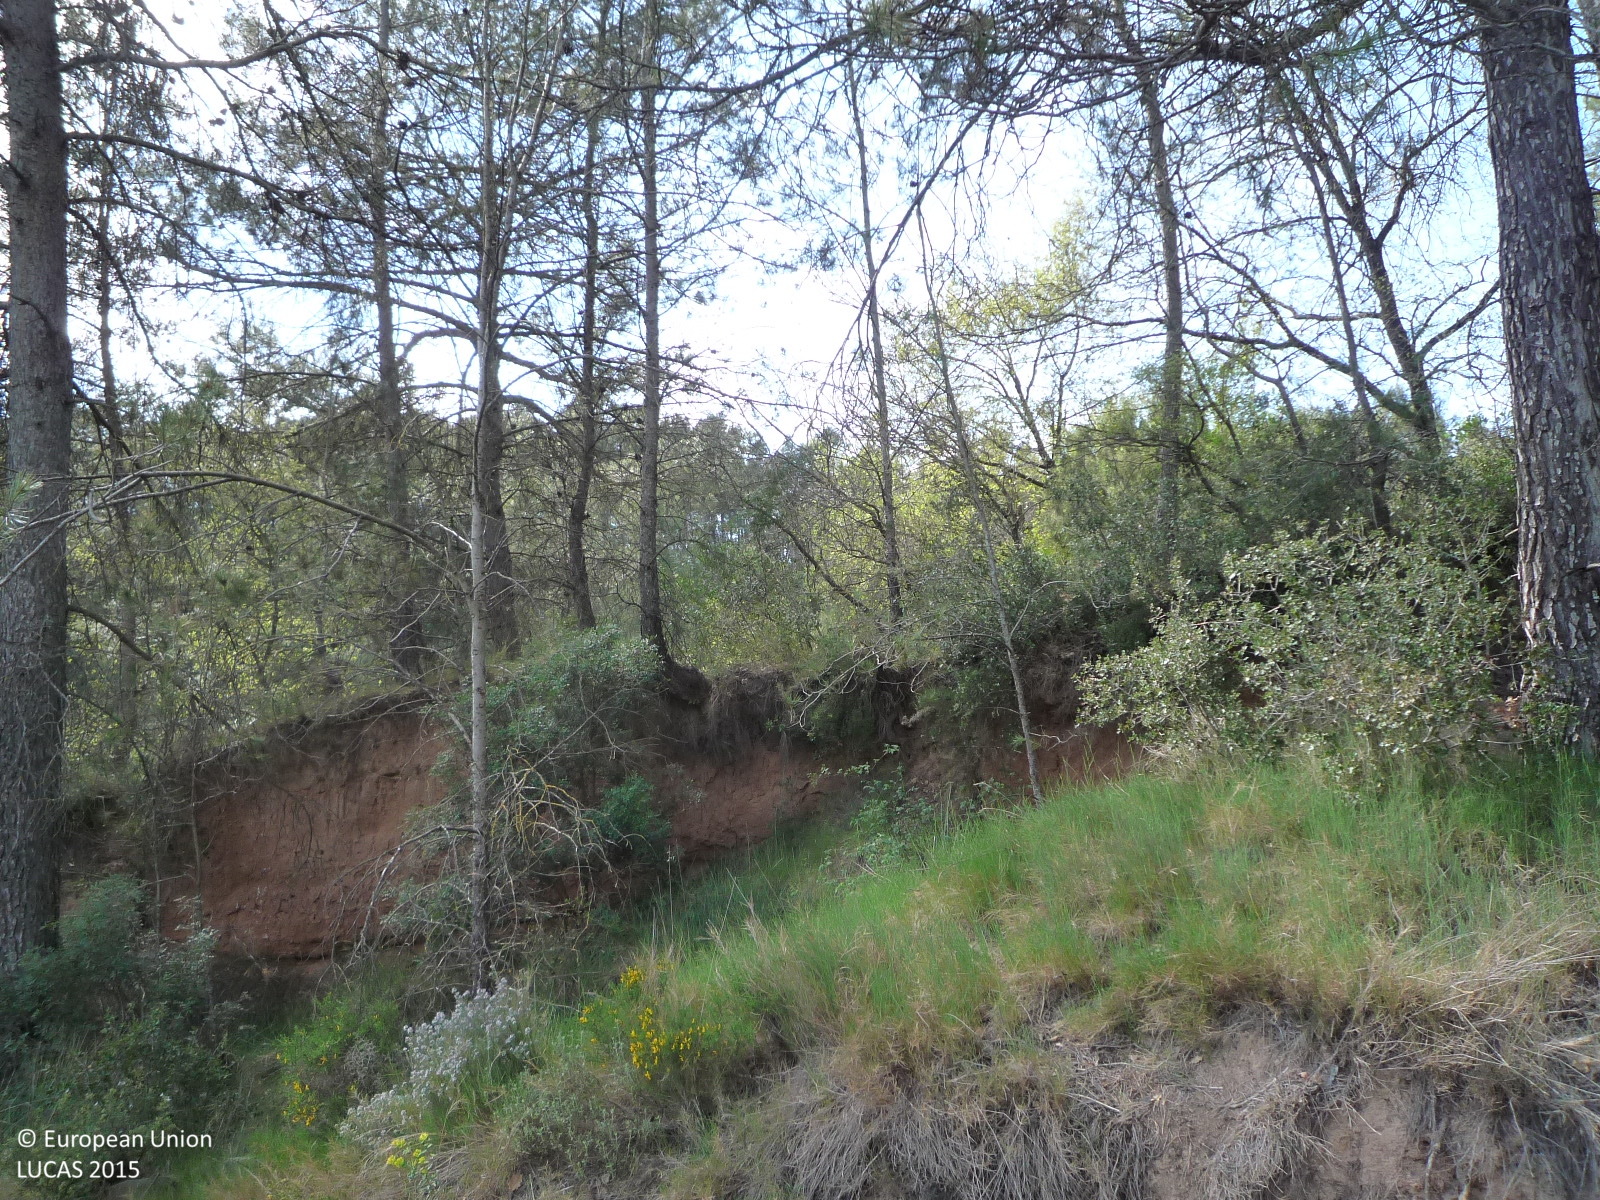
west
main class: Cropland
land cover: Durum wheat
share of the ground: > 75 %
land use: Agriculture (excluding fallow land and kitchen gardens)
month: April
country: ES
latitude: 41.7426
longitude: 1.6094
